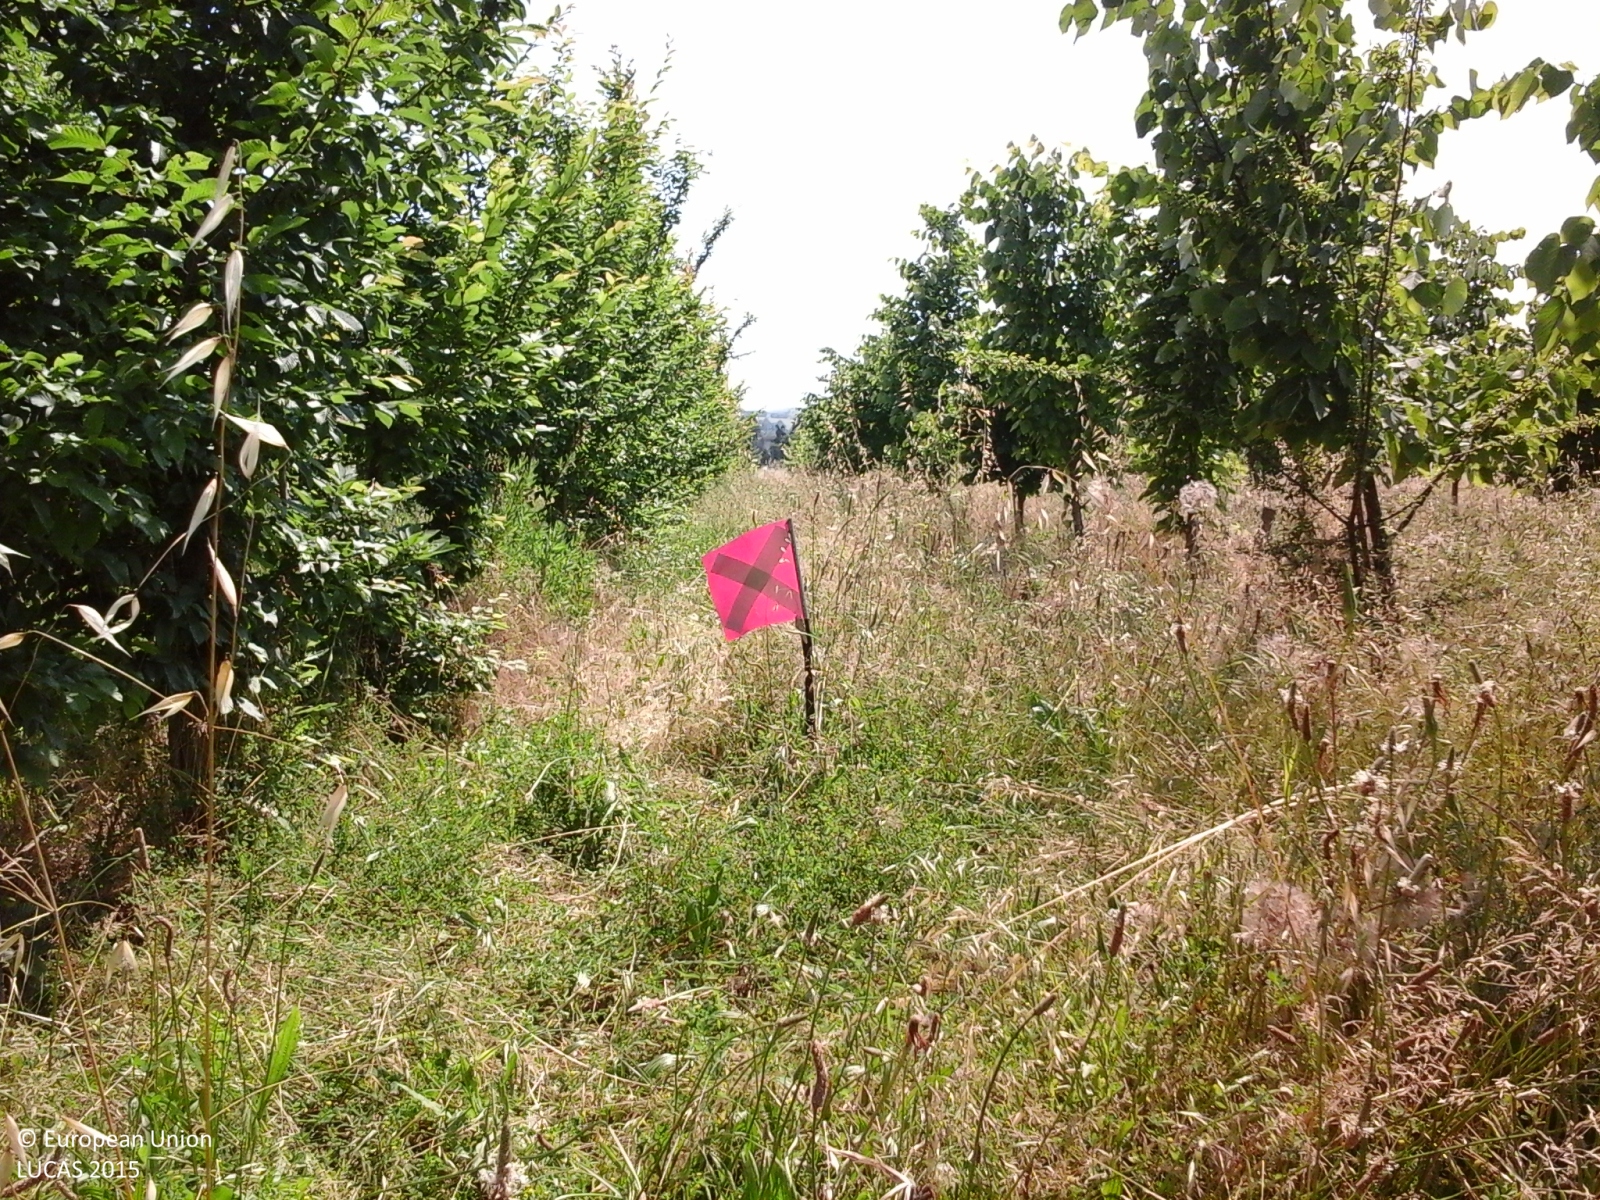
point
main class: Cropland
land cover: Nurseries
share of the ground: 50 - 75 %
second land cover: Spontaneously vegetated surfaces
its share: > 75 %
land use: Agriculture (excluding fallow land and kitchen gardens)
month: June
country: IT
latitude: 44.5060
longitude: 11.1923
